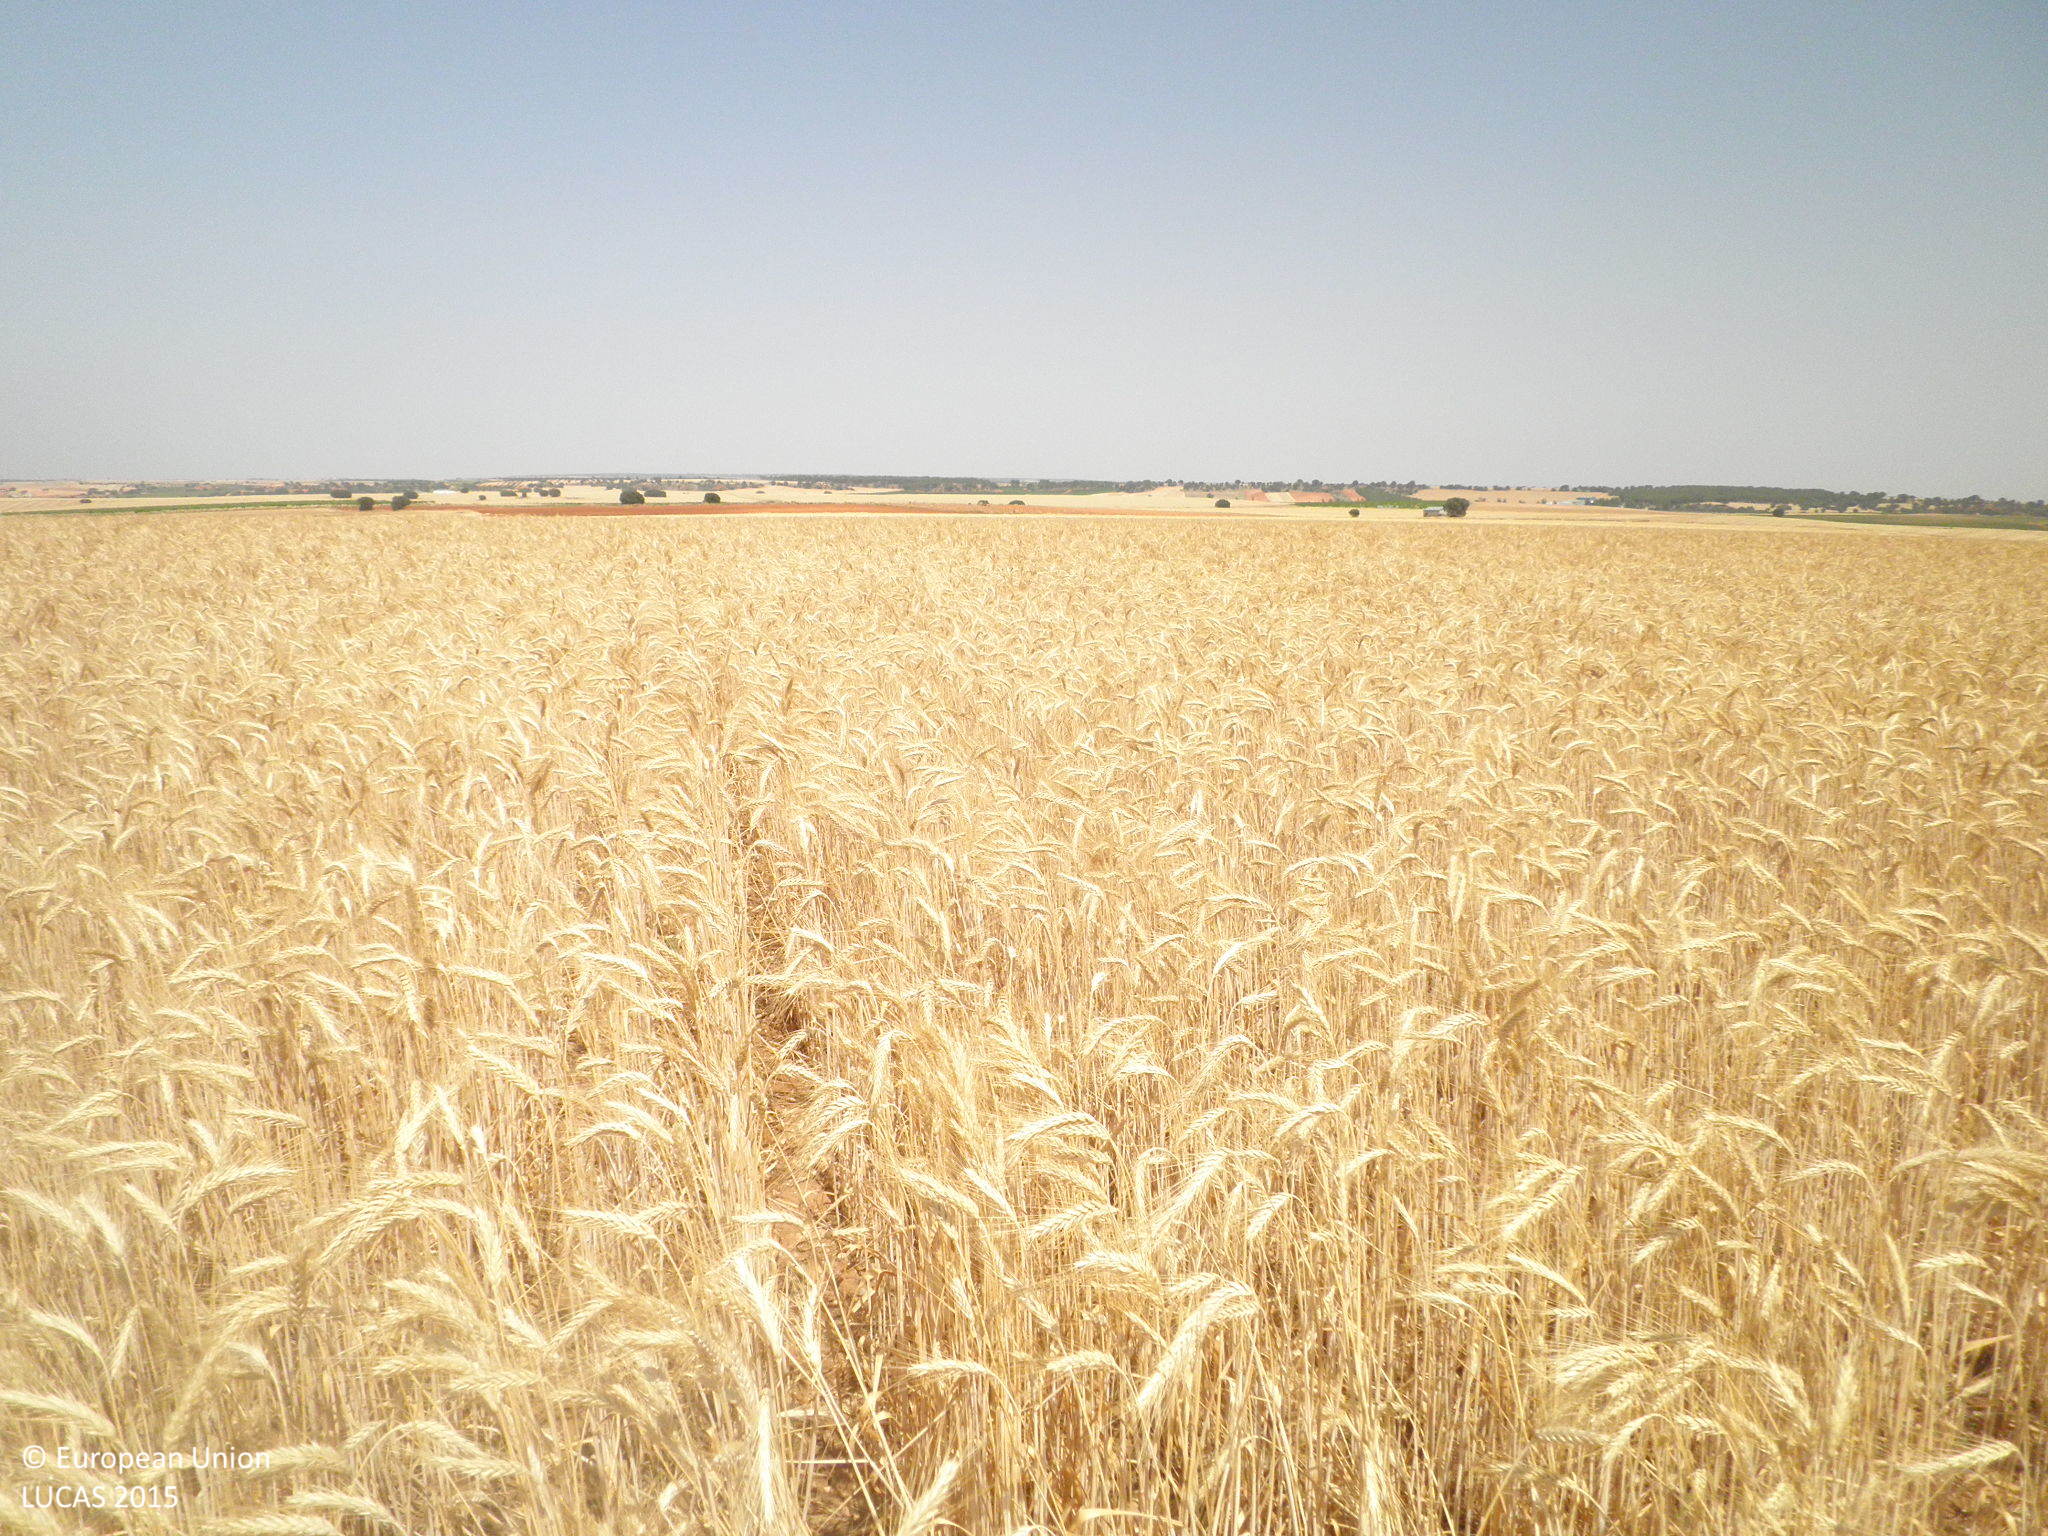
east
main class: Cropland
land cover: Durum wheat
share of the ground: > 75 %
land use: Agriculture (excluding fallow land and kitchen gardens)
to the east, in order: Durum wheat; Tracks; Grass margins; Barley
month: July
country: ES
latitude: 39.4696
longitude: -2.6014
